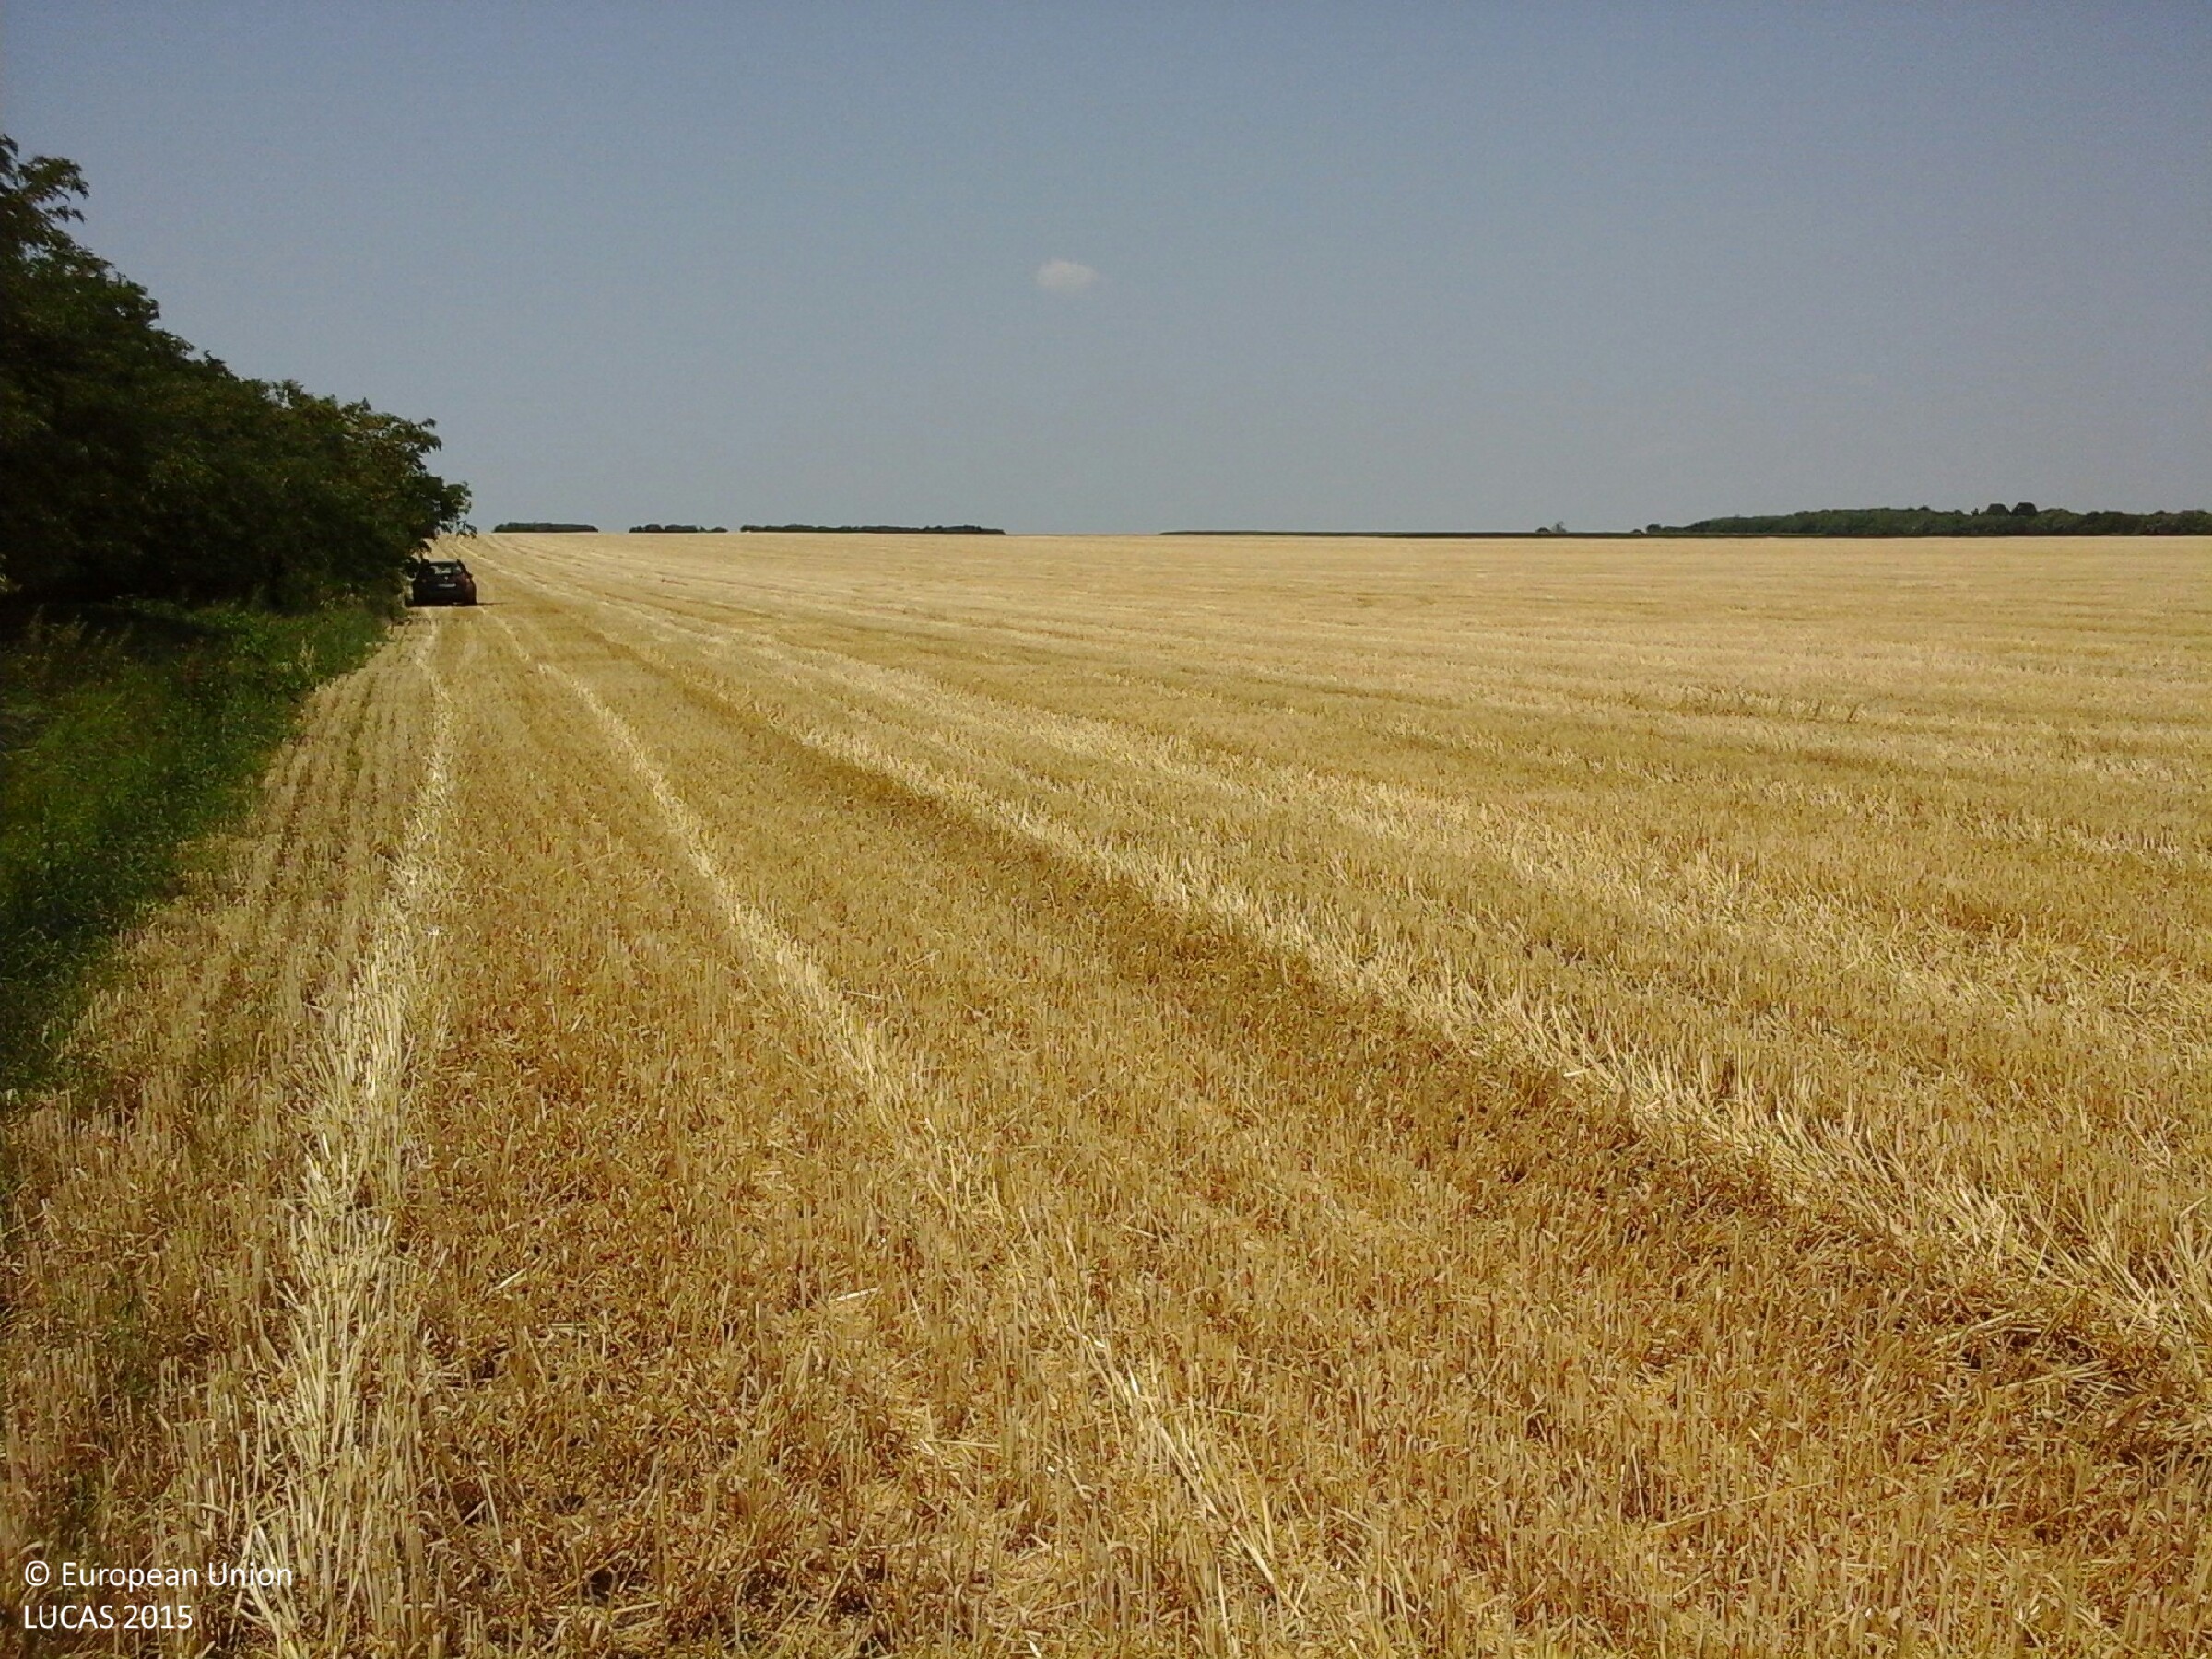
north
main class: Cropland
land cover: Common wheat
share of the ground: > 75 %
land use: Agriculture (excluding fallow land and kitchen gardens)
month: July
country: HU
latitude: 48.0828
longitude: 21.0610
